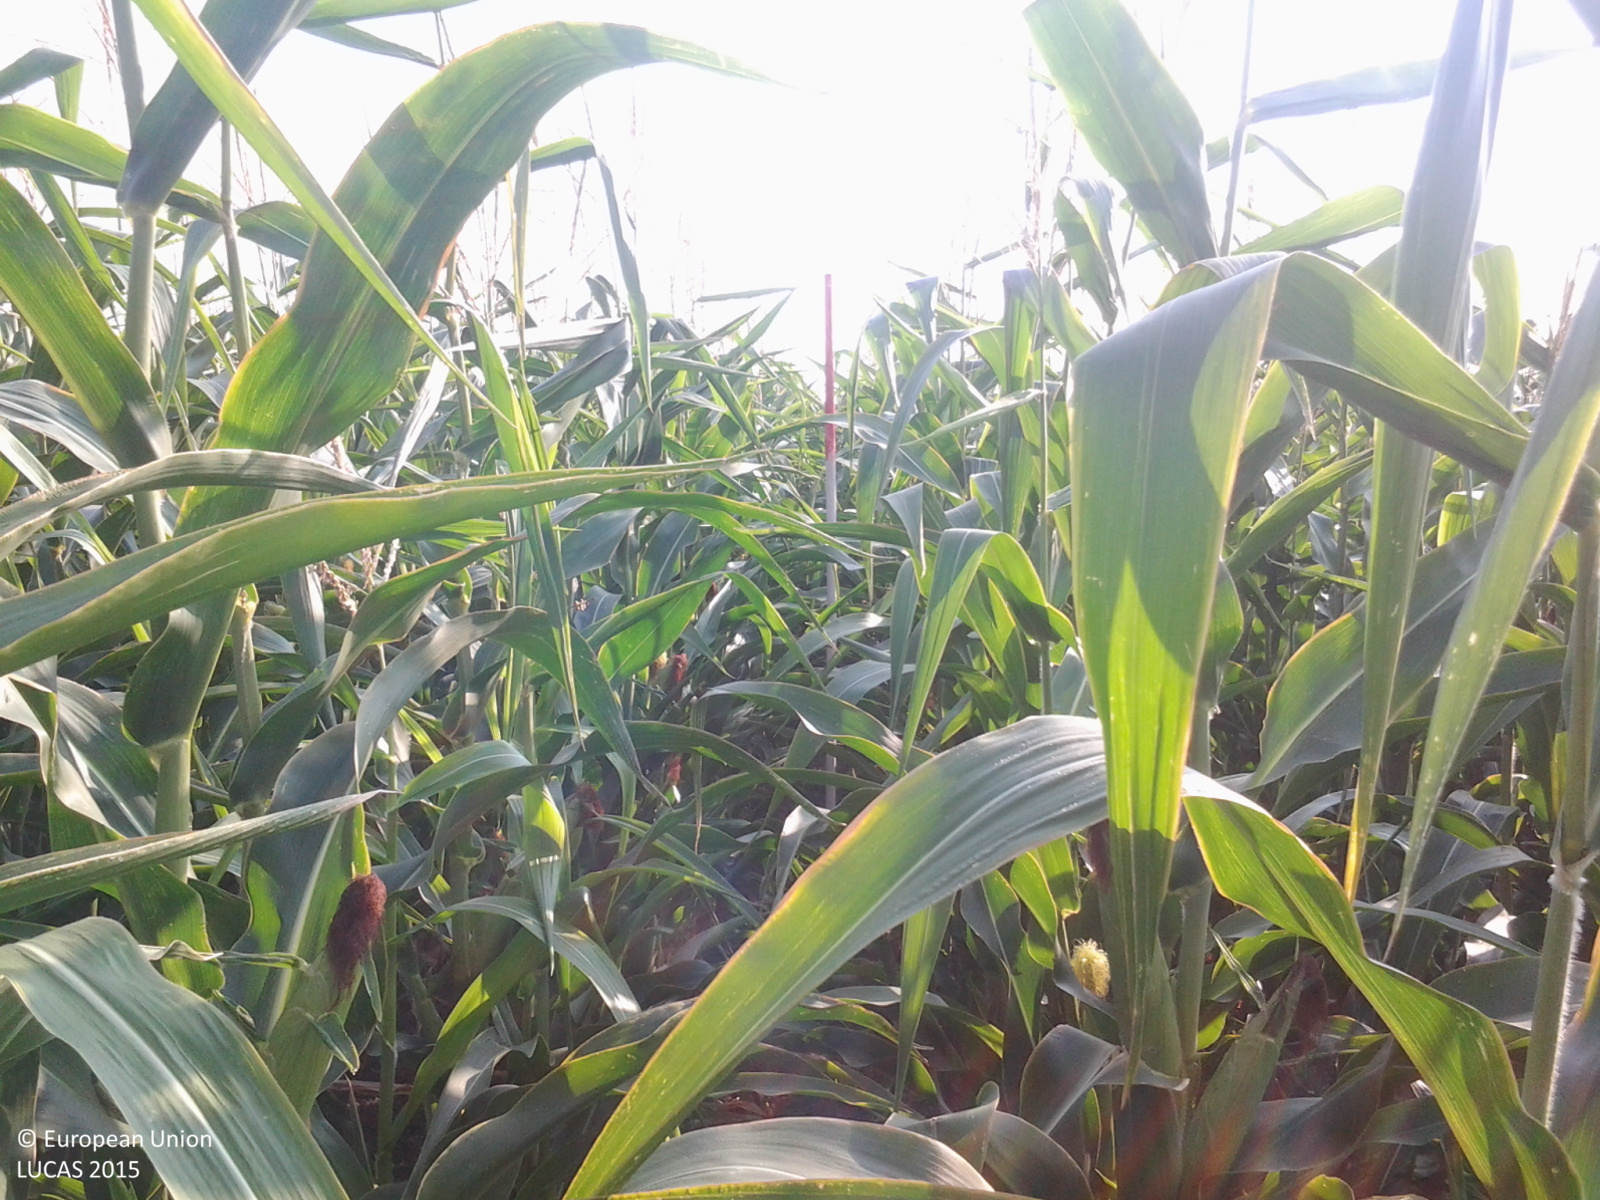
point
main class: Cropland
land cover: Maize
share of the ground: > 75 %
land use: Agriculture (excluding fallow land and kitchen gardens)
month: July
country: HU
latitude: 46.9681
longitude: 20.7697
